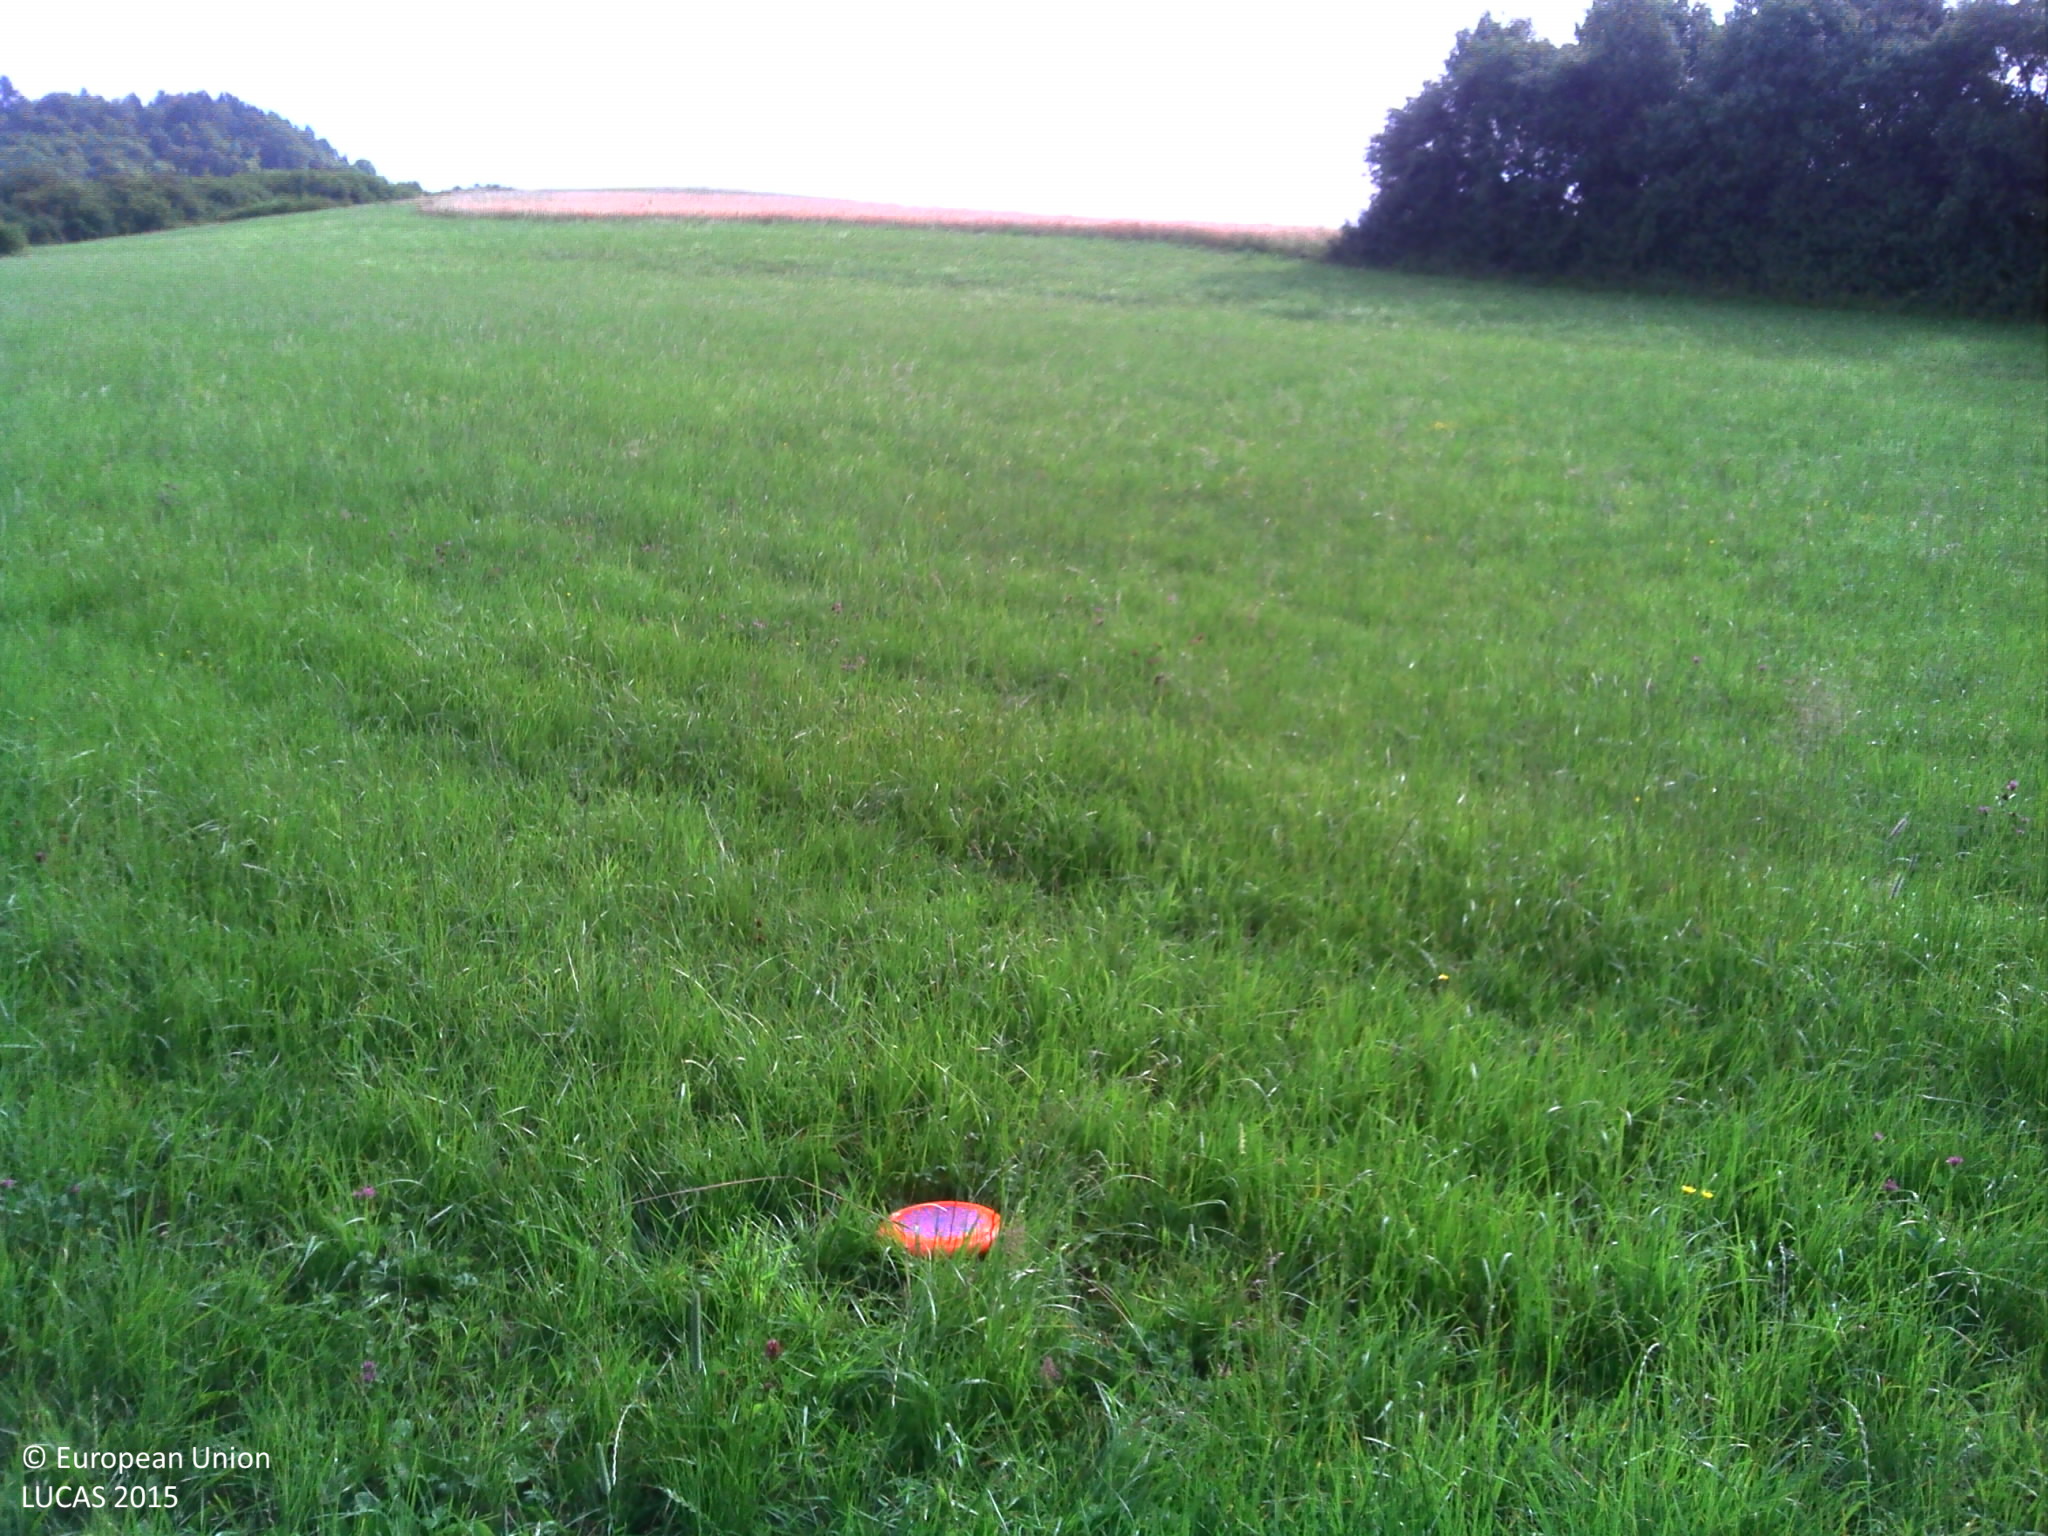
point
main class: Grassland
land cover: Grassland without tree/shrub cover
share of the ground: > 75 %
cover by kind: herbaceous plants 100 %
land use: Agriculture (excluding fallow land and kitchen gardens)
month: June
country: LU
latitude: 49.7487
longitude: 6.3773
